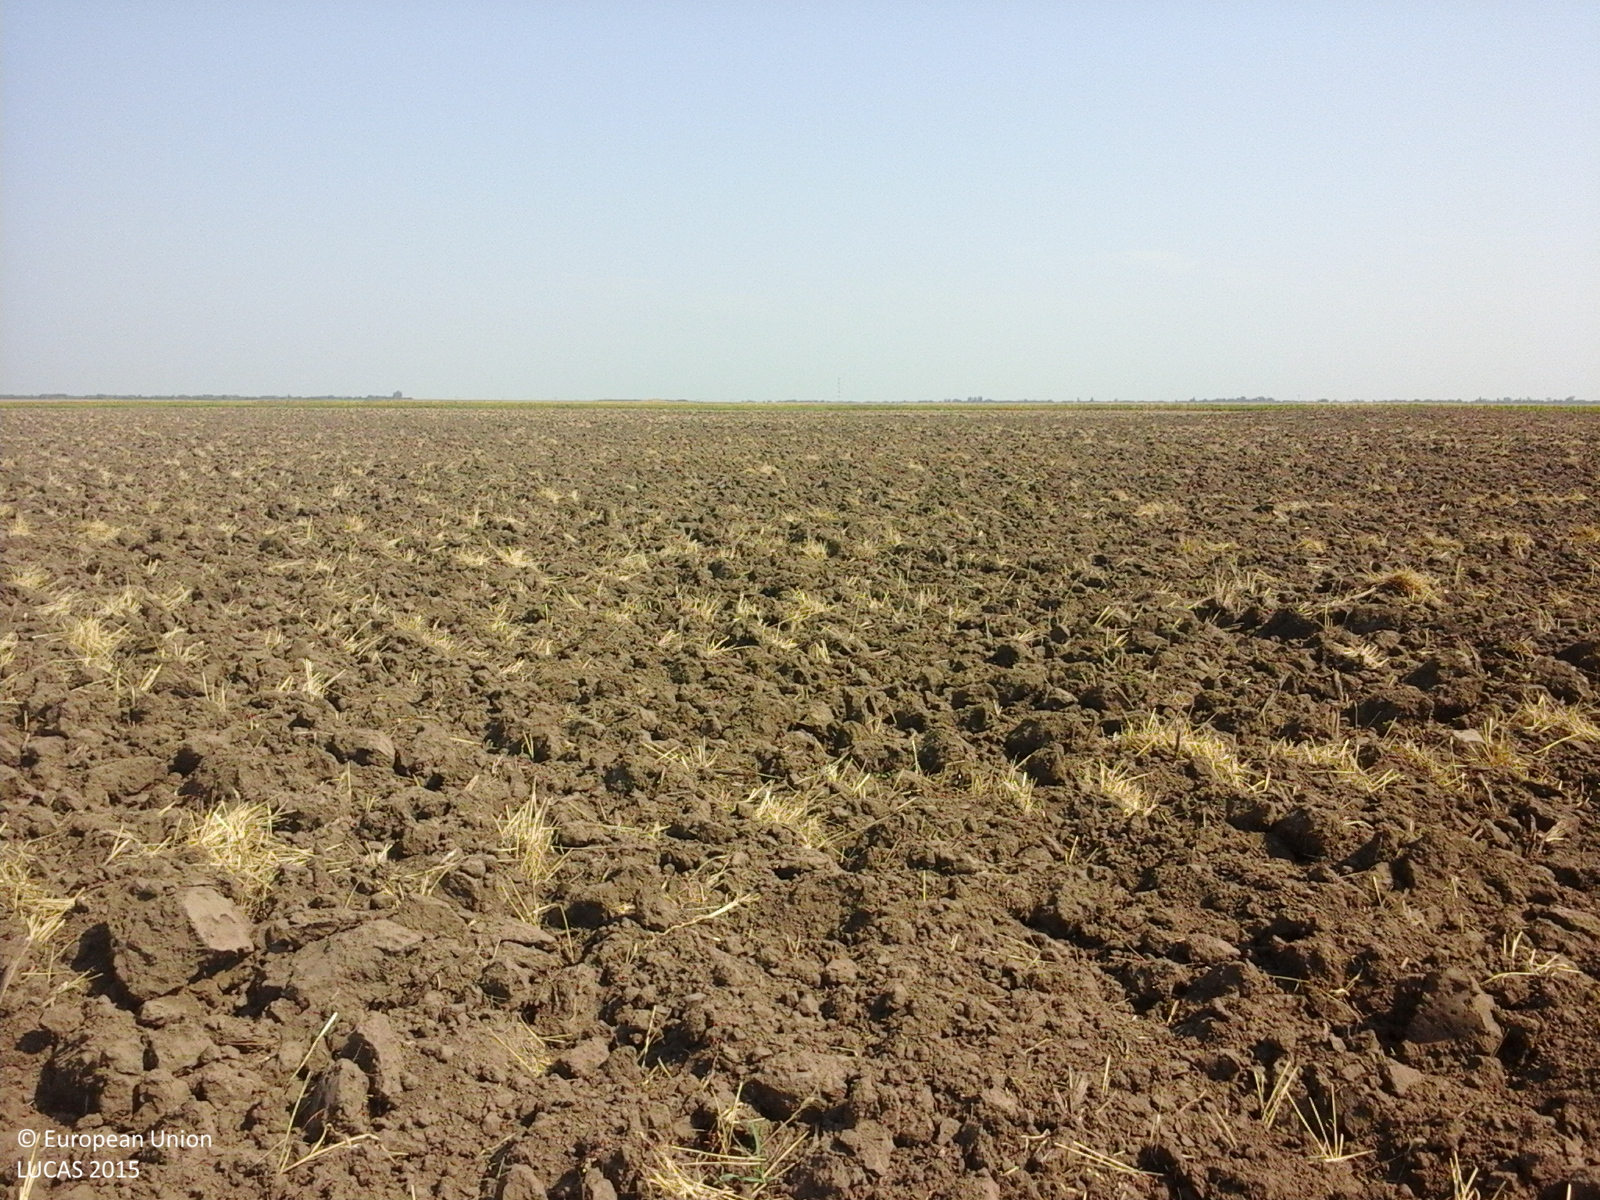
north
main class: Cropland
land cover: Common wheat
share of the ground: < 10 %
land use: Agriculture (excluding fallow land and kitchen gardens)
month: August
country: RO
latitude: 45.0834
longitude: 27.3595
